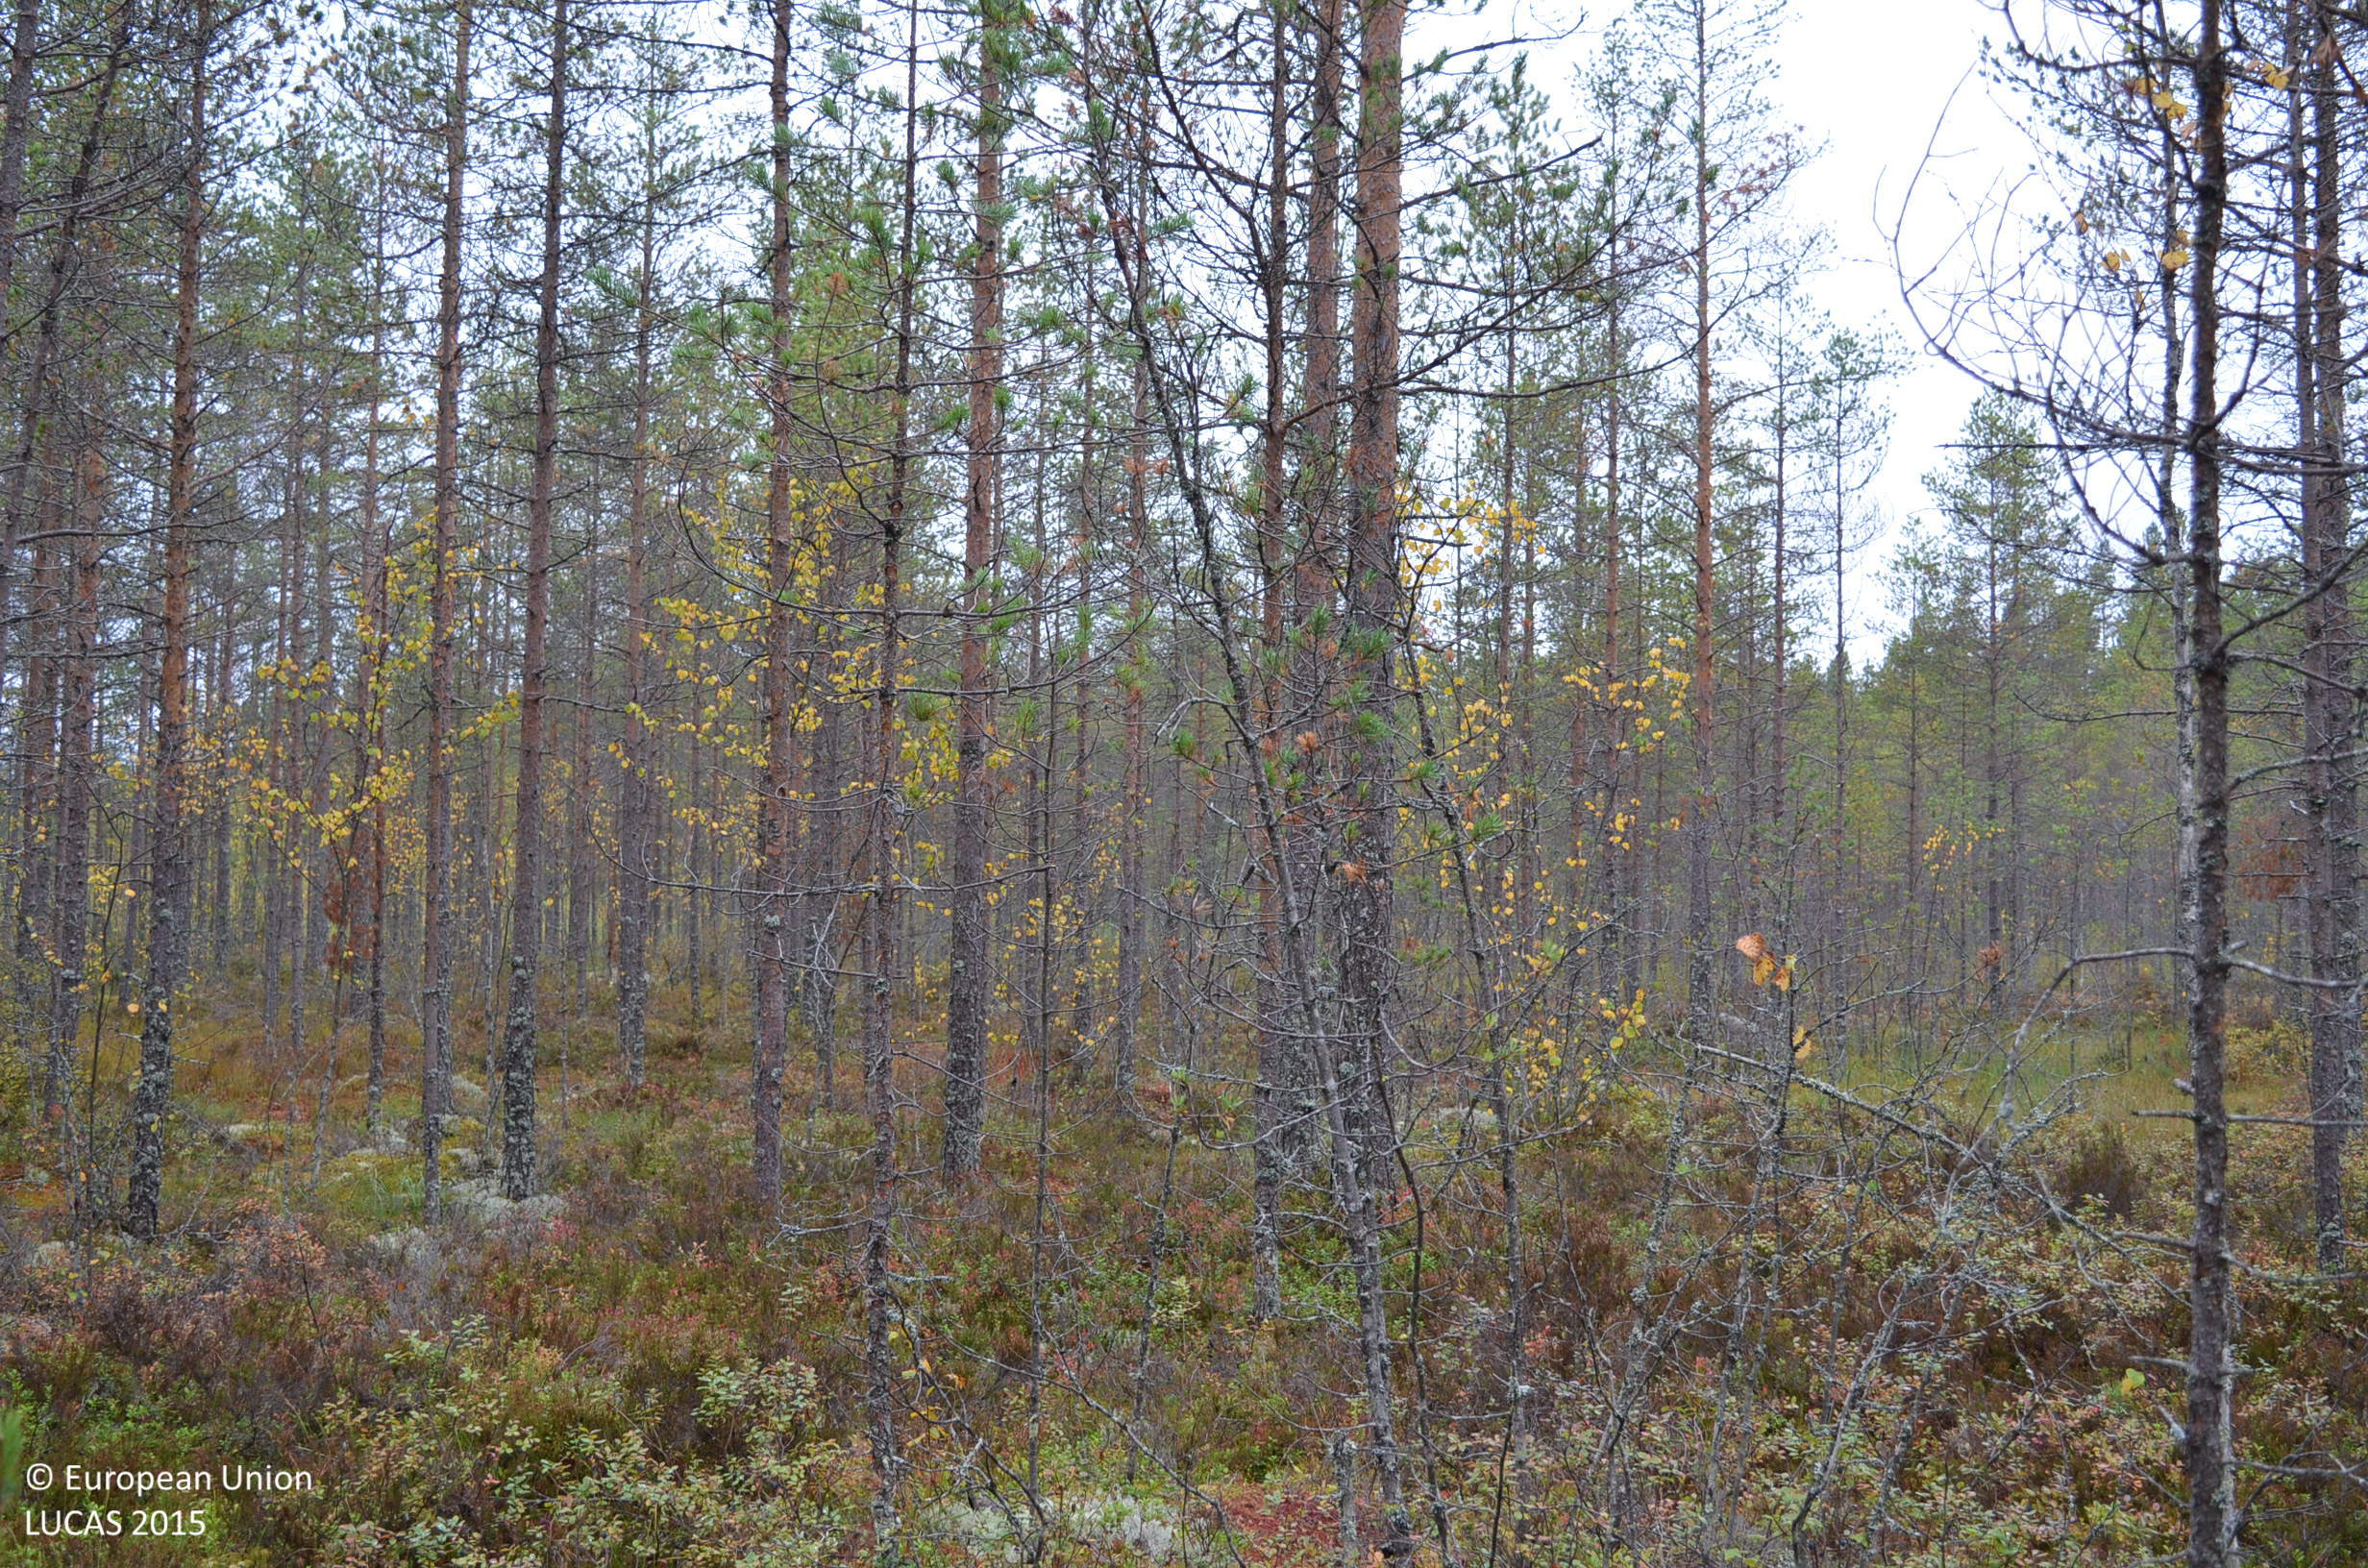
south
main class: Woodland
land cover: Pine dominated coniferous woodland
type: boreal forest
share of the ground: 50 - 75 %
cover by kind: coniferous forest trees 60 %, shrubs 35 %, broadleaved forest trees 5 %
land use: Forestry
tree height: > 5 m
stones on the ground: < 10 %
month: September
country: FI
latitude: 62.8431
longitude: 23.7205
